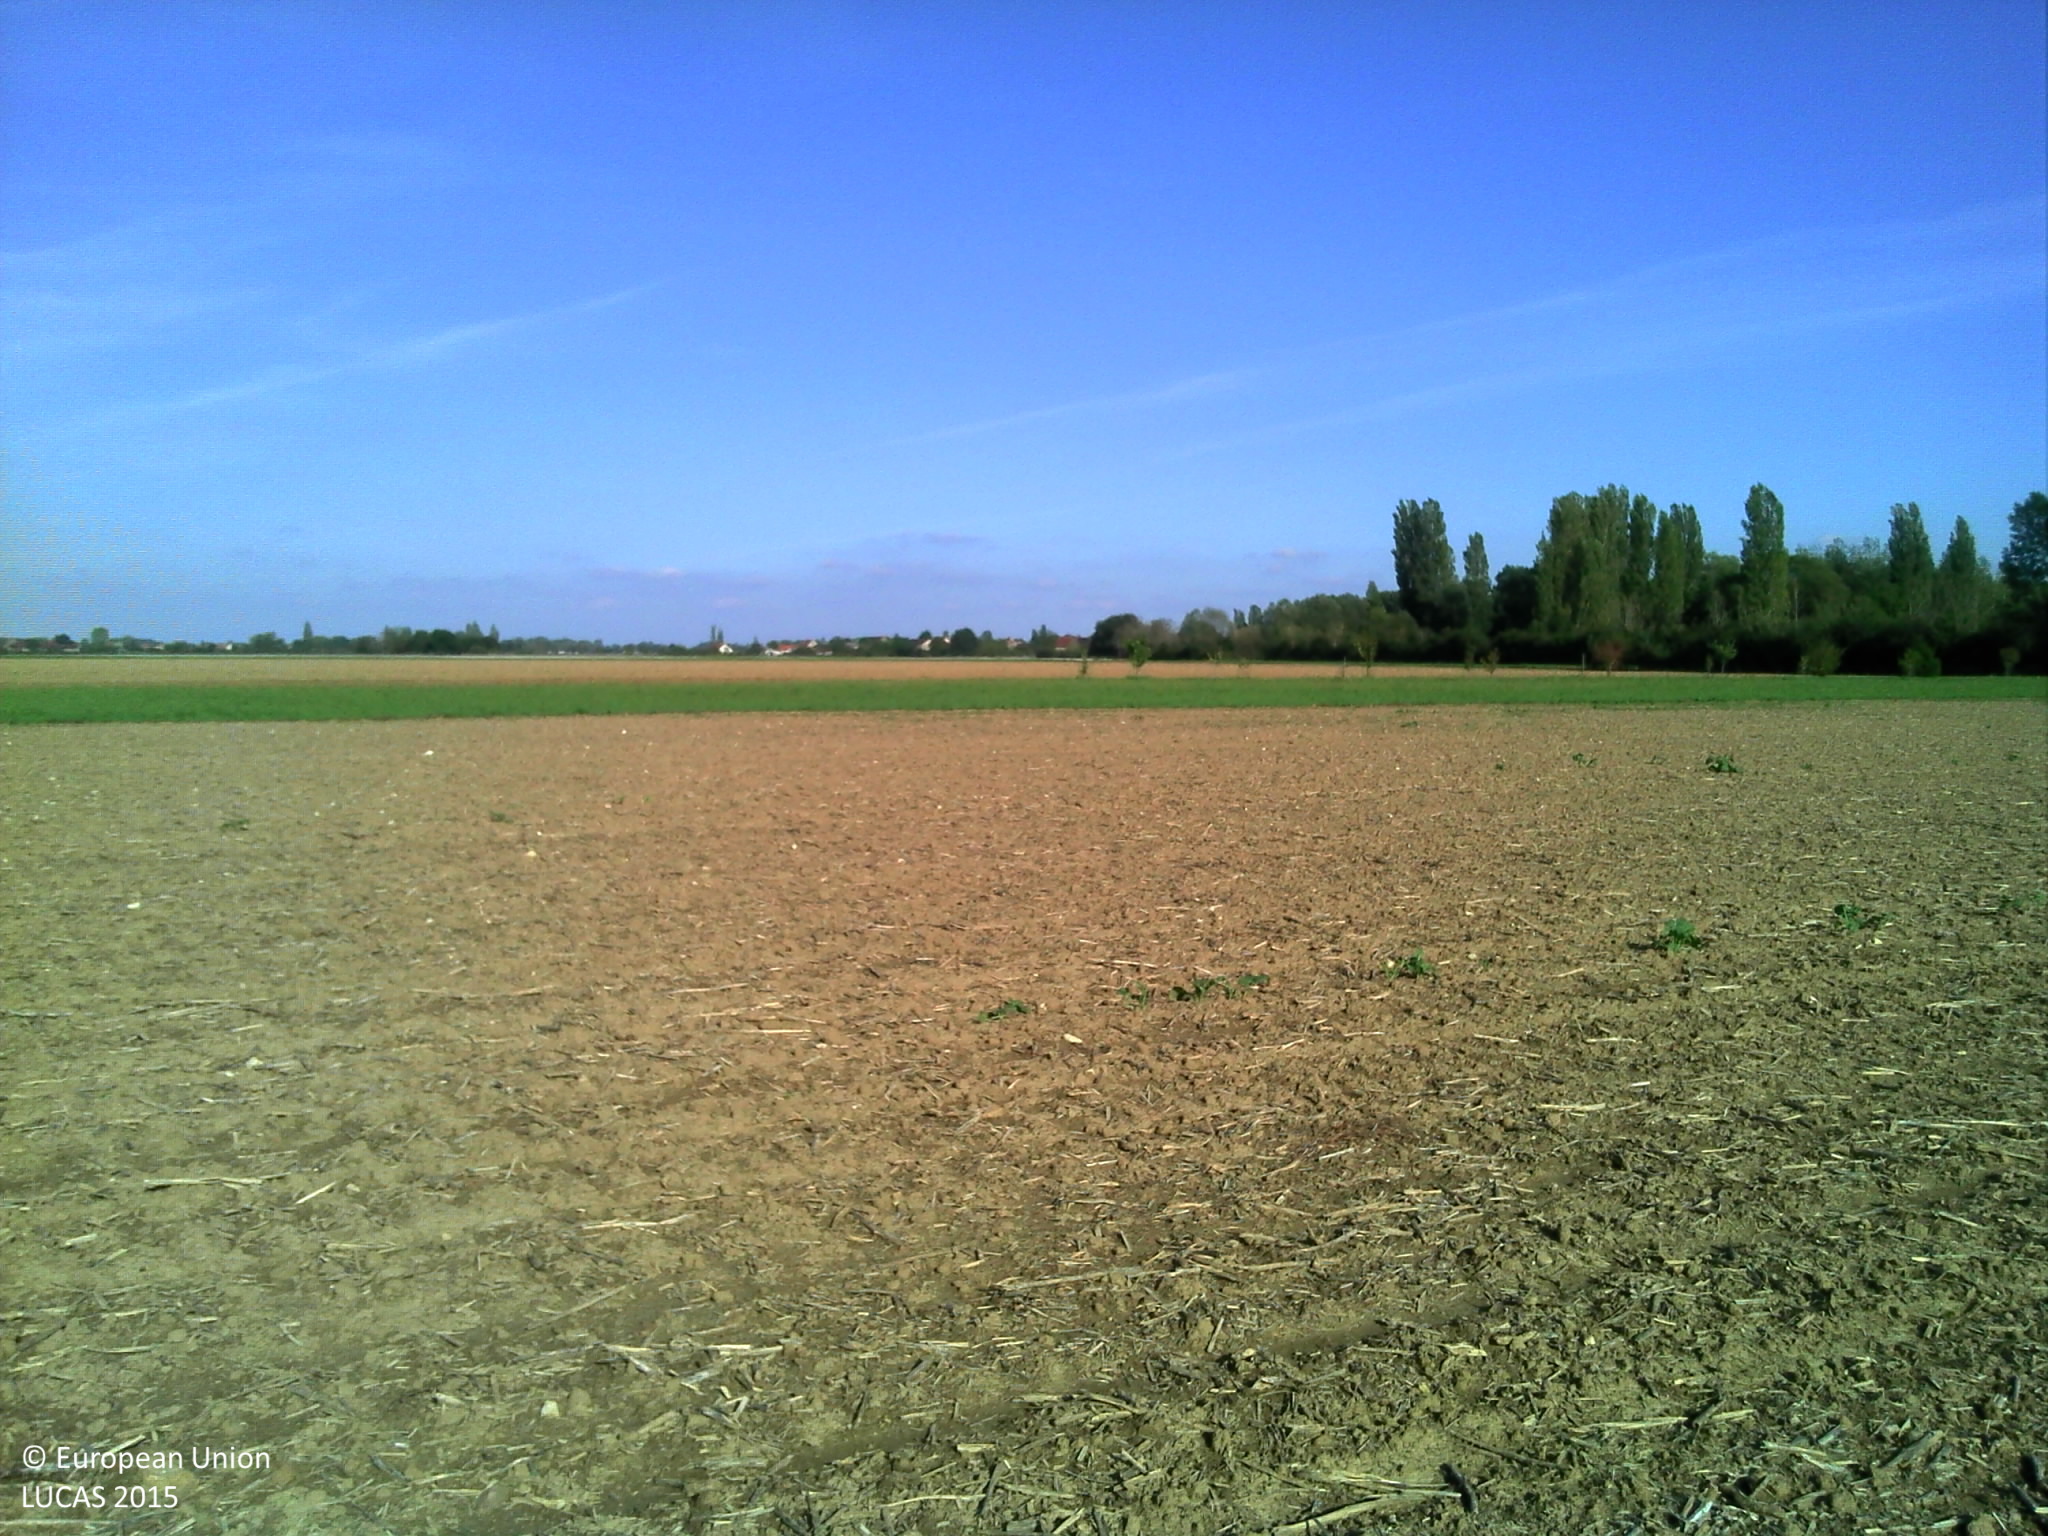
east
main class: Cropland
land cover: Rape and turnip rape
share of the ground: < 10 %
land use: Agriculture (excluding fallow land and kitchen gardens)
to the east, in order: Rape and turnip rape; Grassland without tree/shrub cover; Cherry fruit; Grassland without tree/shrub cover; Ditches and canals; Grass margins; Other bare soil
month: September
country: FR
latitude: 46.9279
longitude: 4.7869
